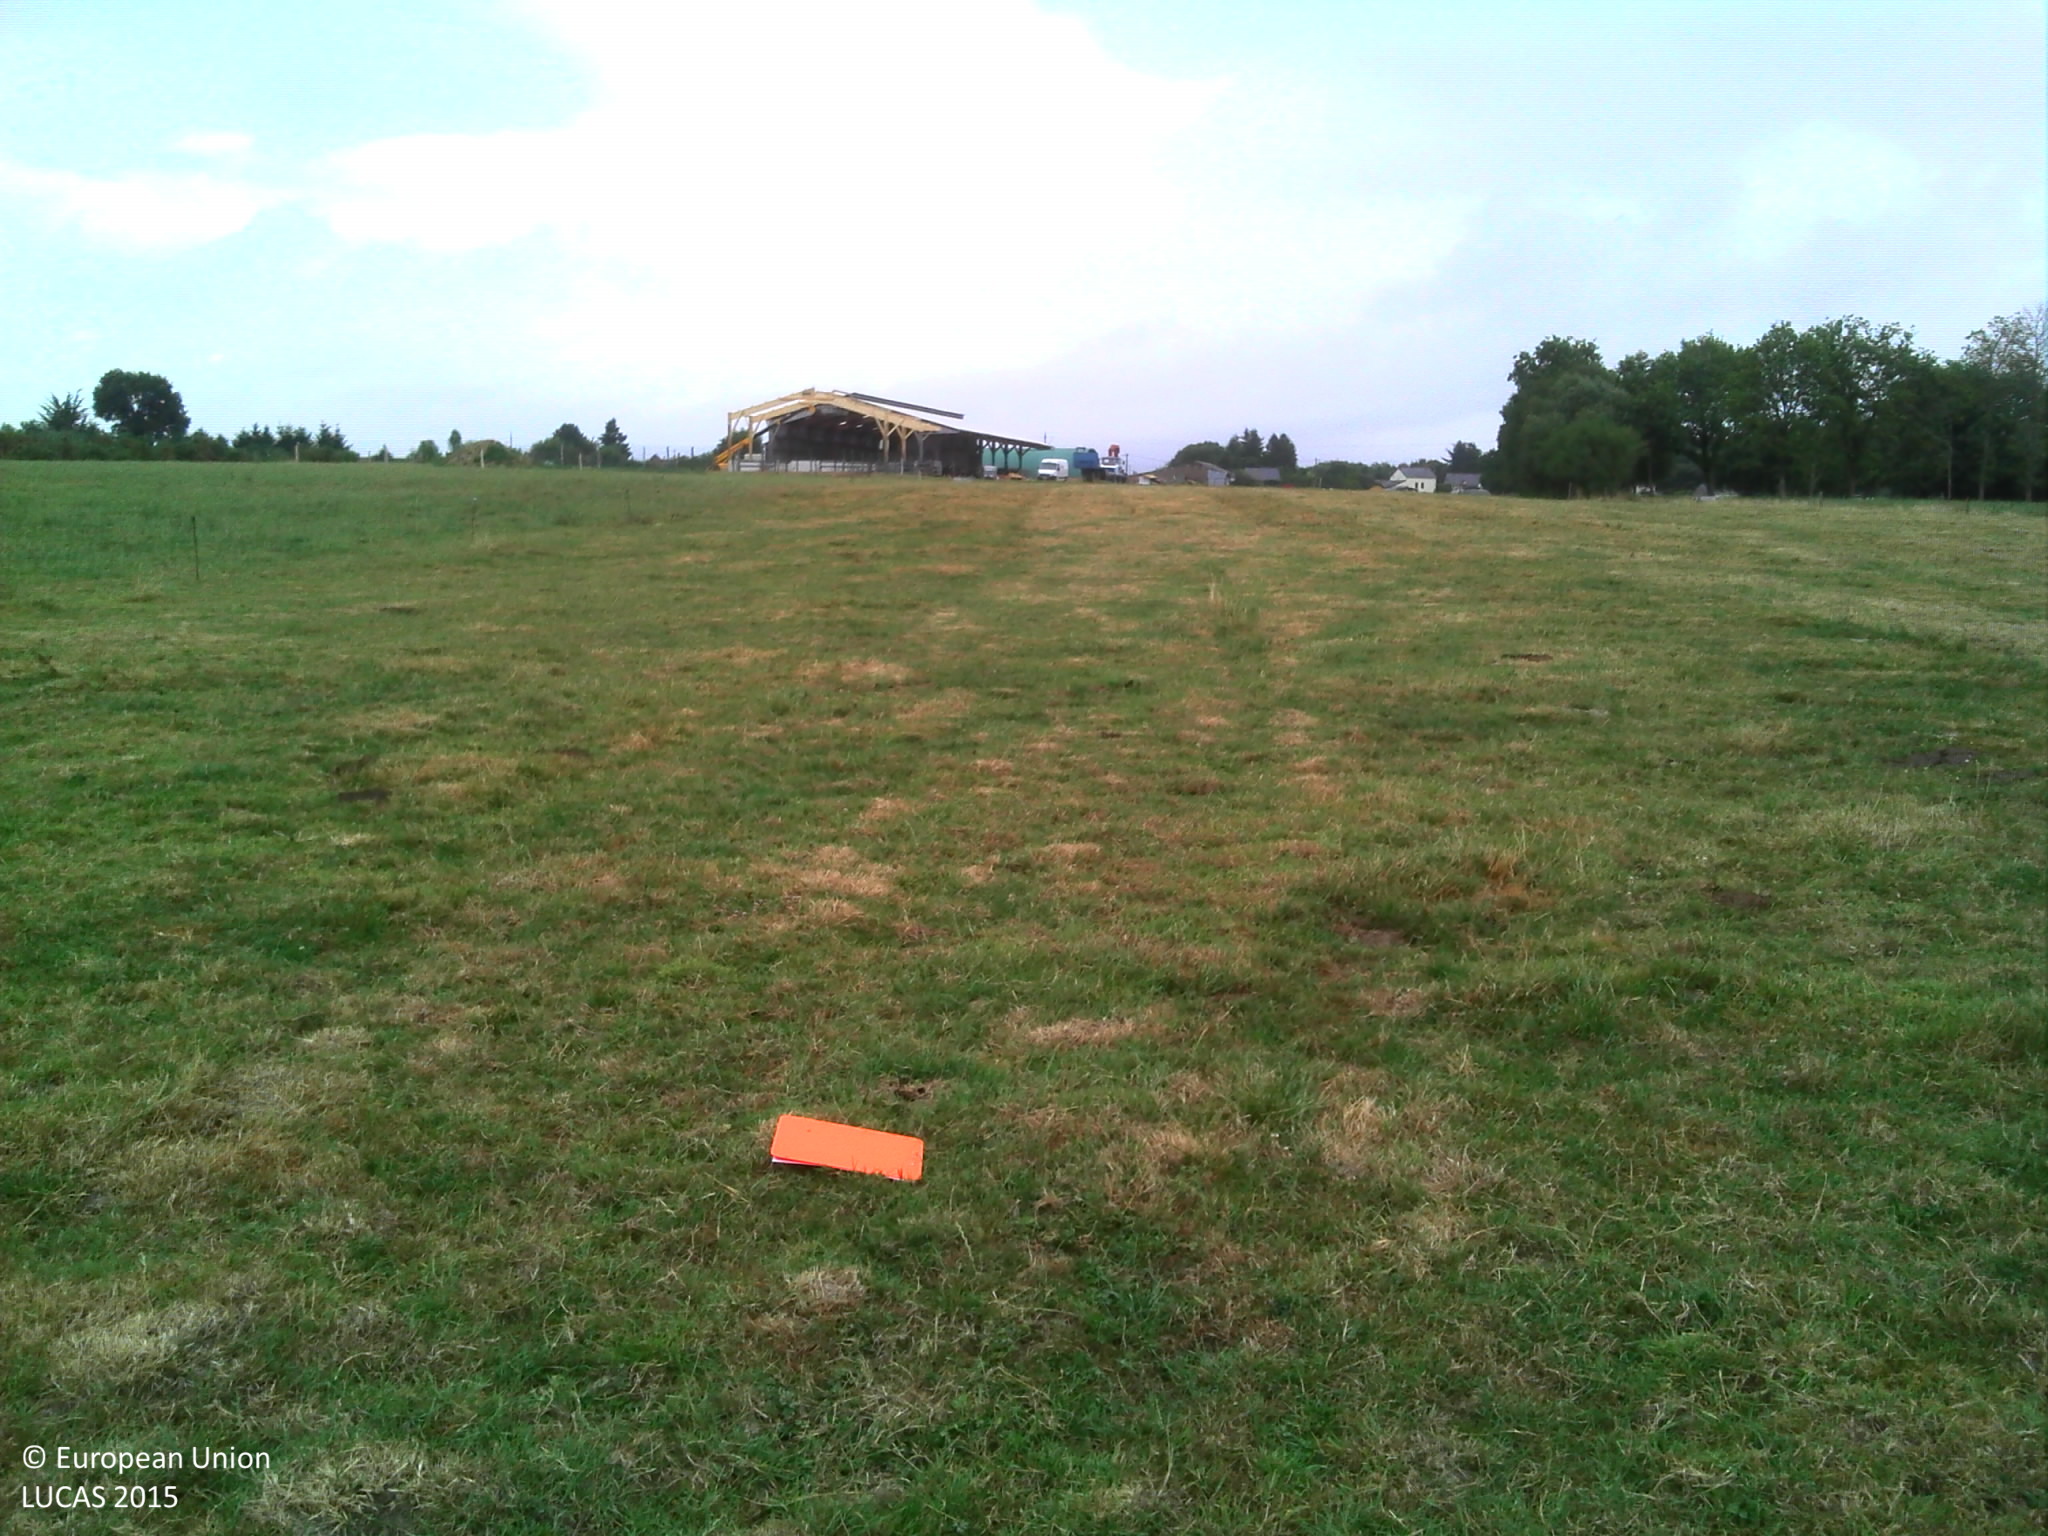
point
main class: Cropland
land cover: Temporary grasslands
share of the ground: > 75 %
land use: Agriculture (excluding fallow land and kitchen gardens)
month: July
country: FR
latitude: 47.4826
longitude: -1.9259
